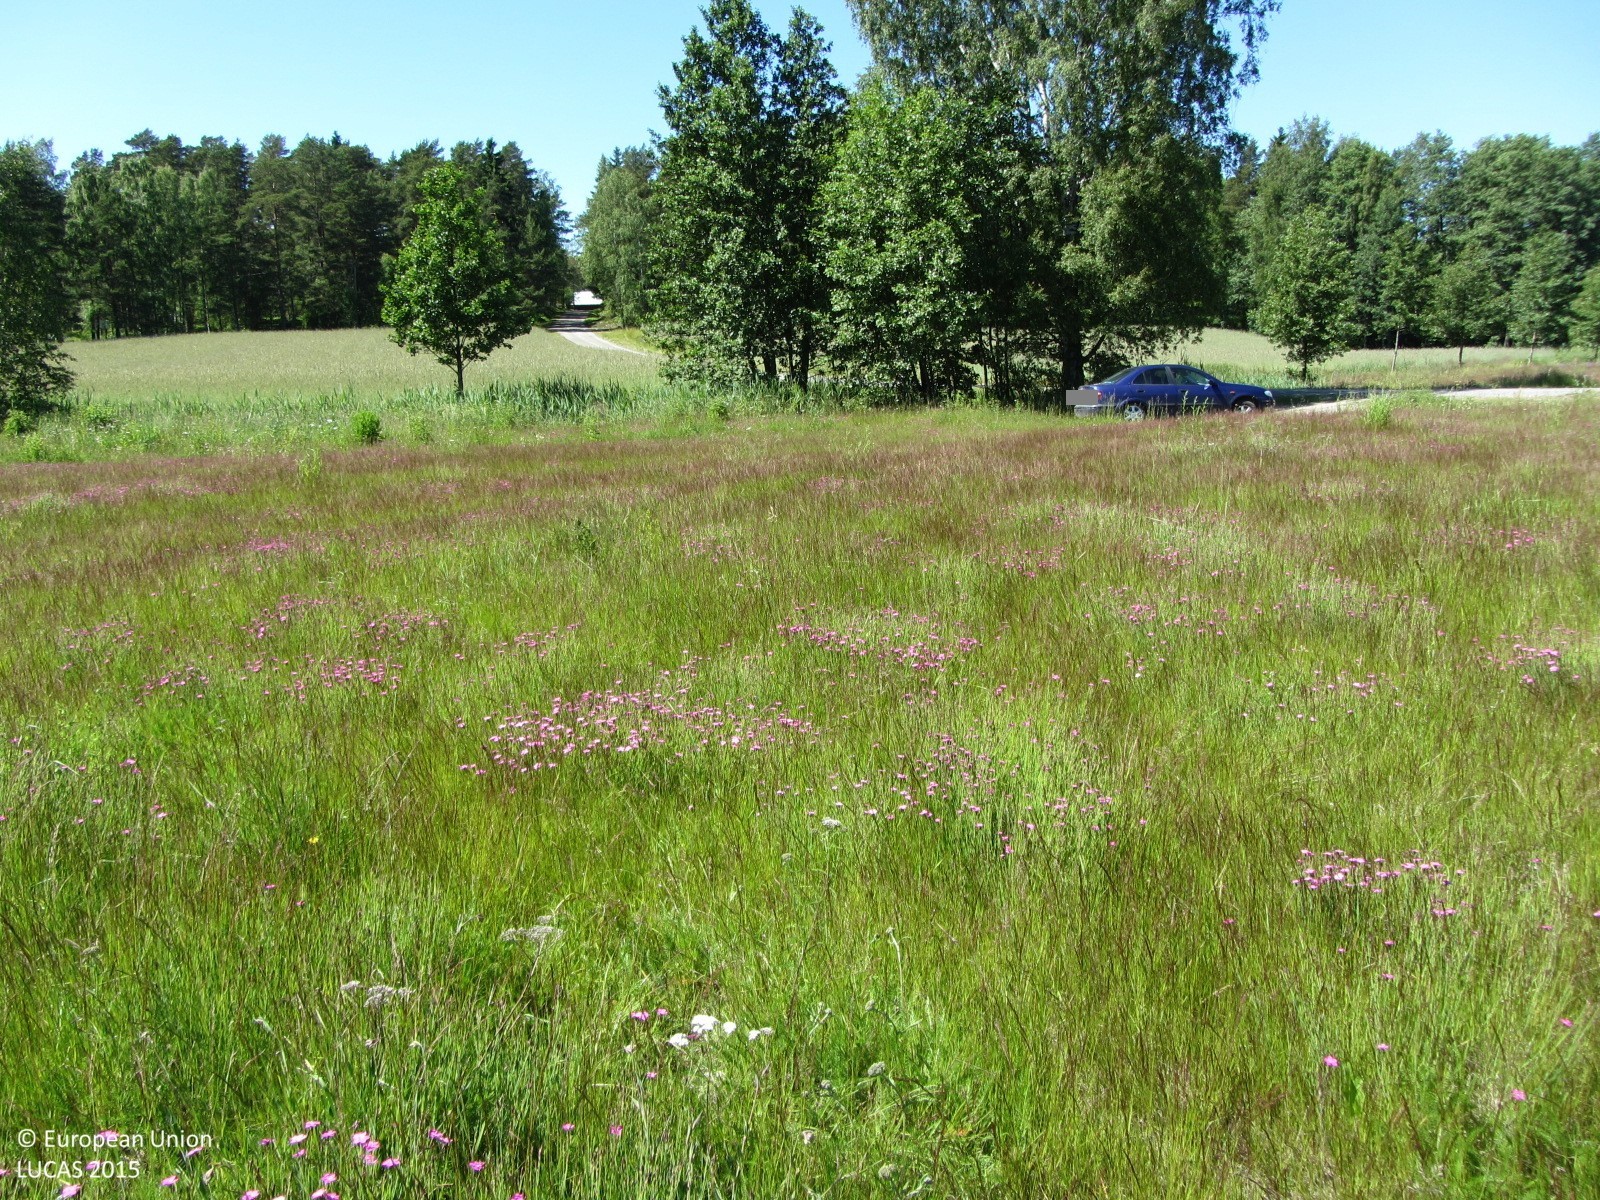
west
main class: Grassland
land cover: Grassland without tree/shrub cover
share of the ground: > 75 %
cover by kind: herbaceous plants 100 %
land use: Agriculture (excluding fallow land and kitchen gardens)
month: July
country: FI
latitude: 59.9260
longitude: 23.1623
